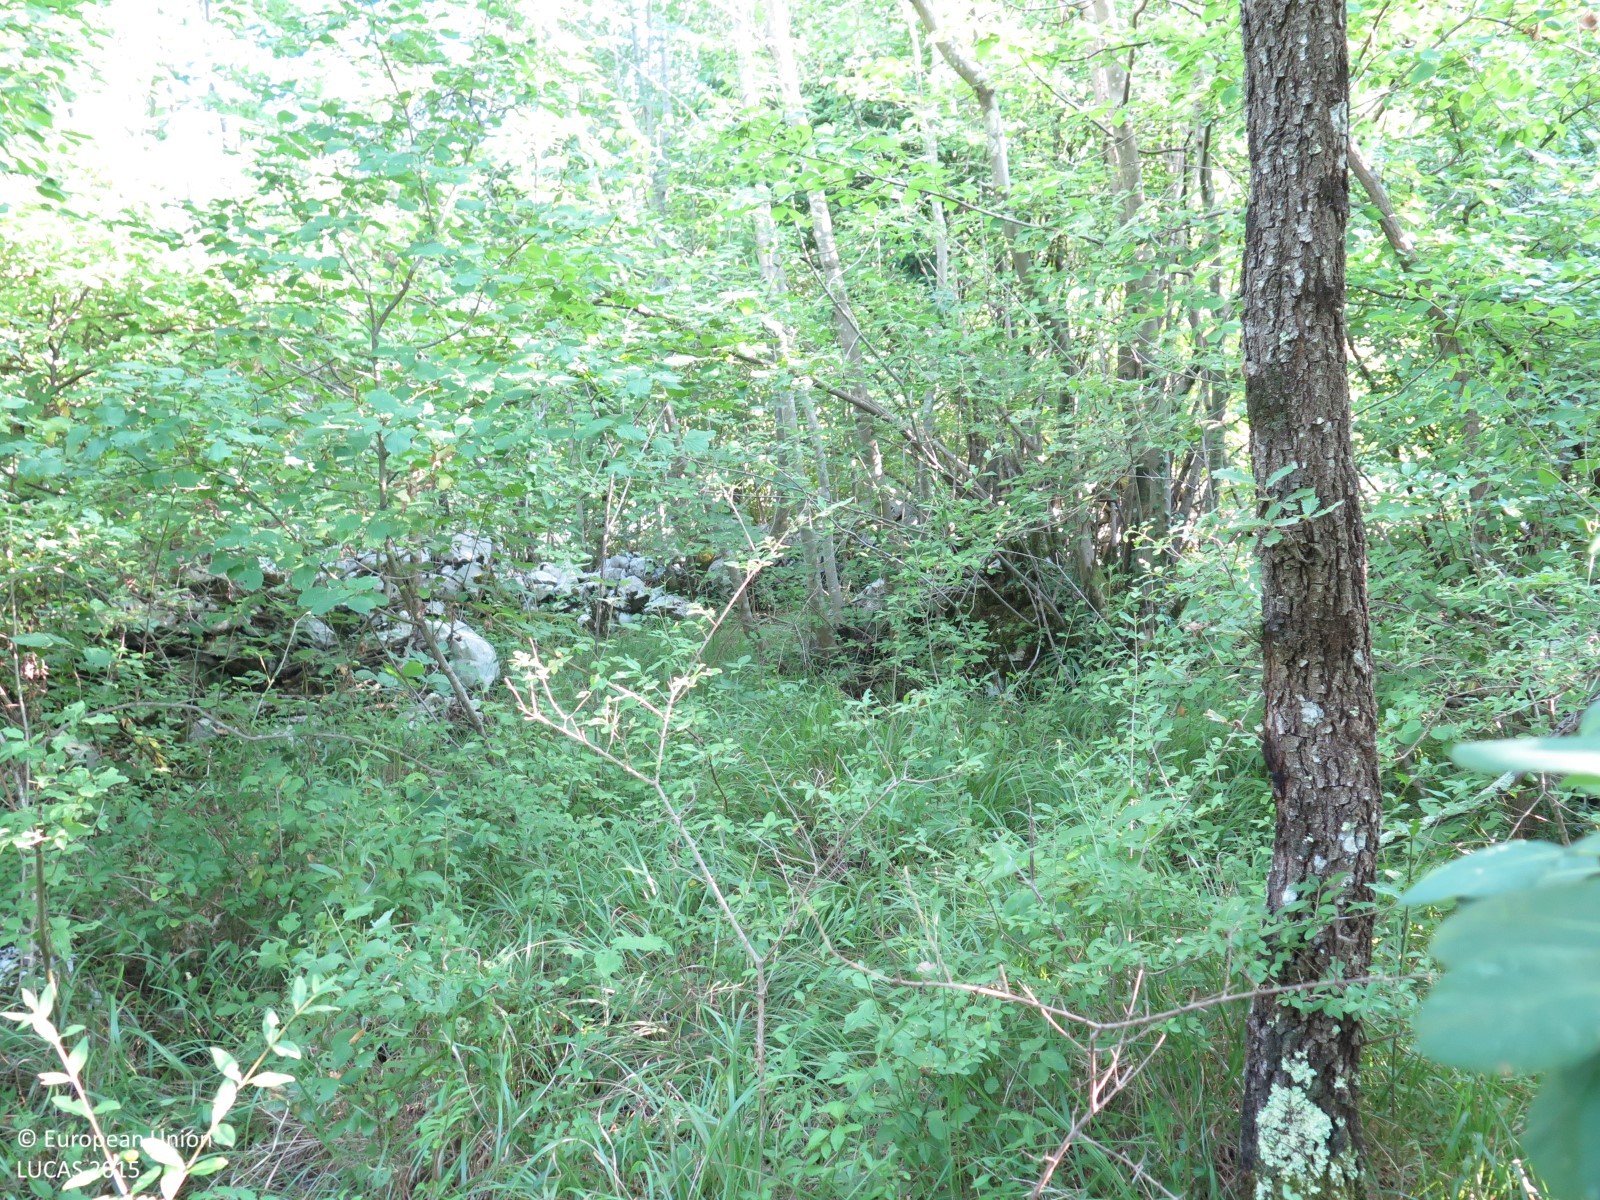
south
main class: Woodland
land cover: Broadleaved woodland
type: acidophilous oak and oak-birch forest
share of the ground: > 75 %
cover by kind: broadleaved forest trees 90 %, shrubs 5 %, herbaceous plants 5 %
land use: Semi-natural and natural areas not in use
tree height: > 5 m
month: July
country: HR
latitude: 45.3719
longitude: 14.0683
